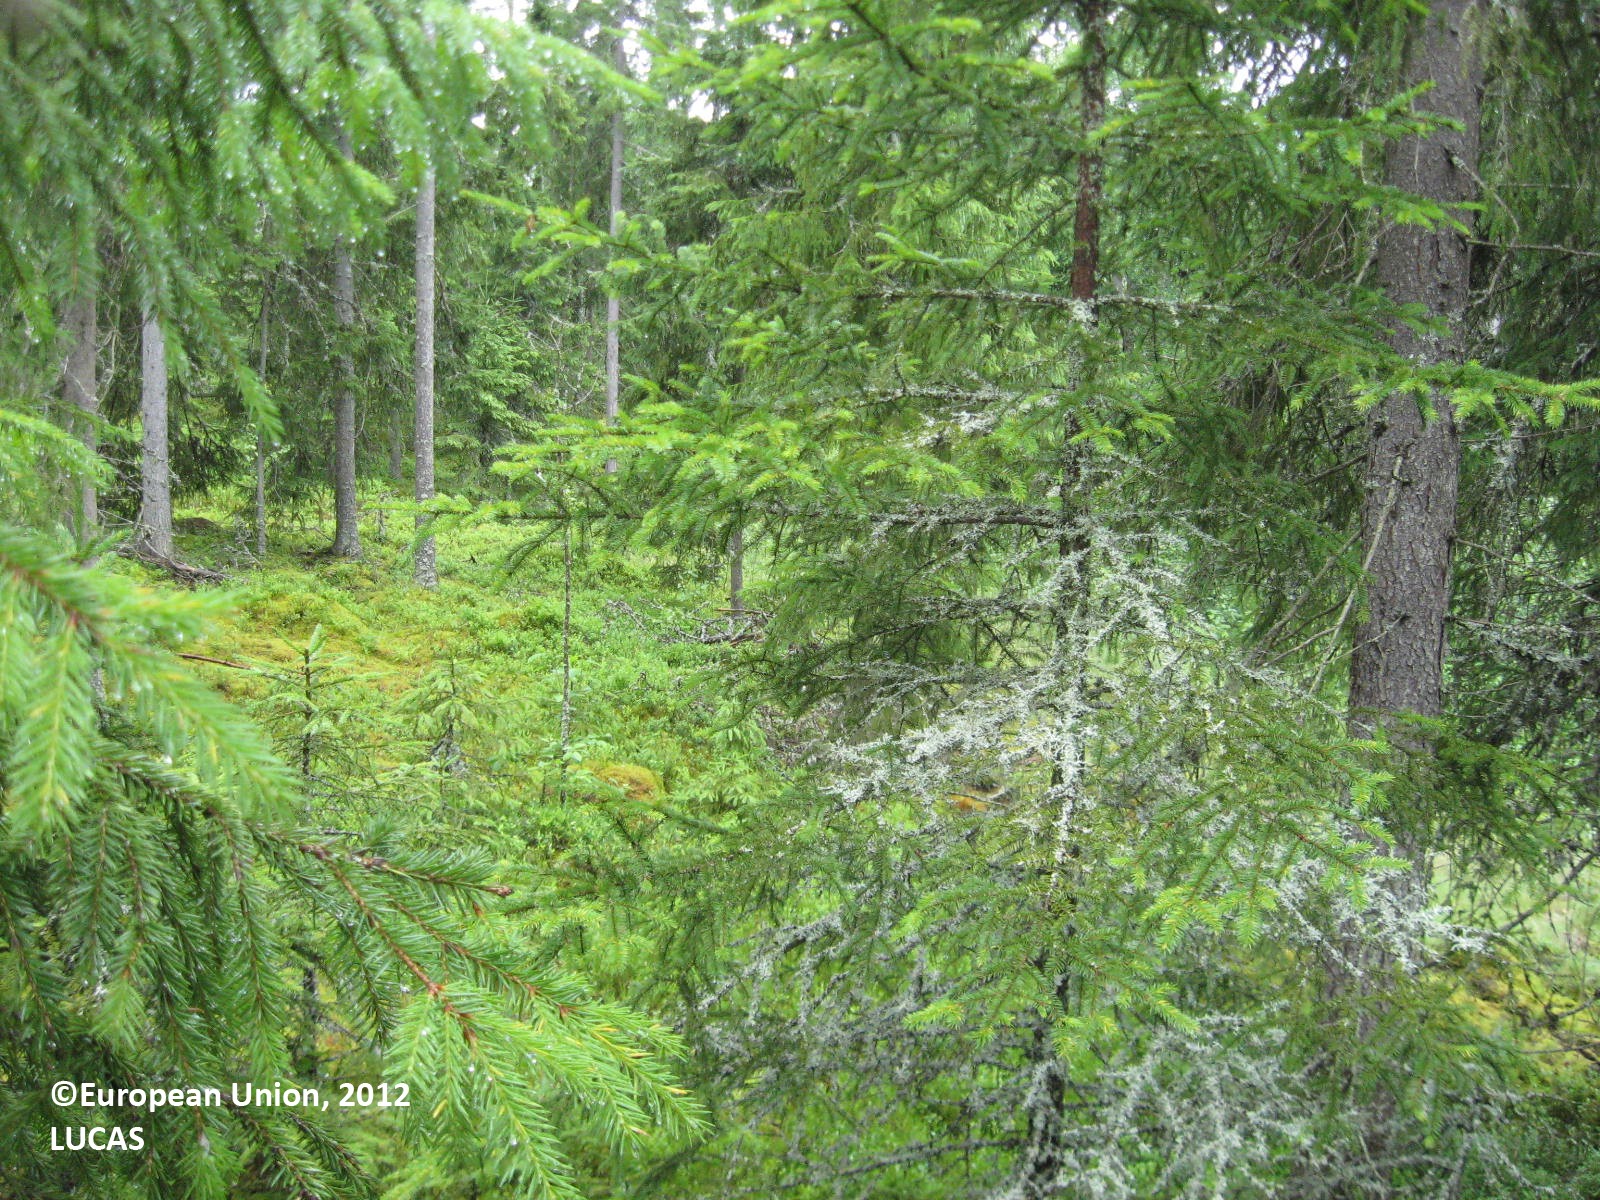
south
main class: Woodland
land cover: Pine dominated coniferous woodland
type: boreal forest
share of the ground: > 75 %
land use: Forestry
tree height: > 5 m
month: July
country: FI
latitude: 62.3425
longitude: 22.7477
